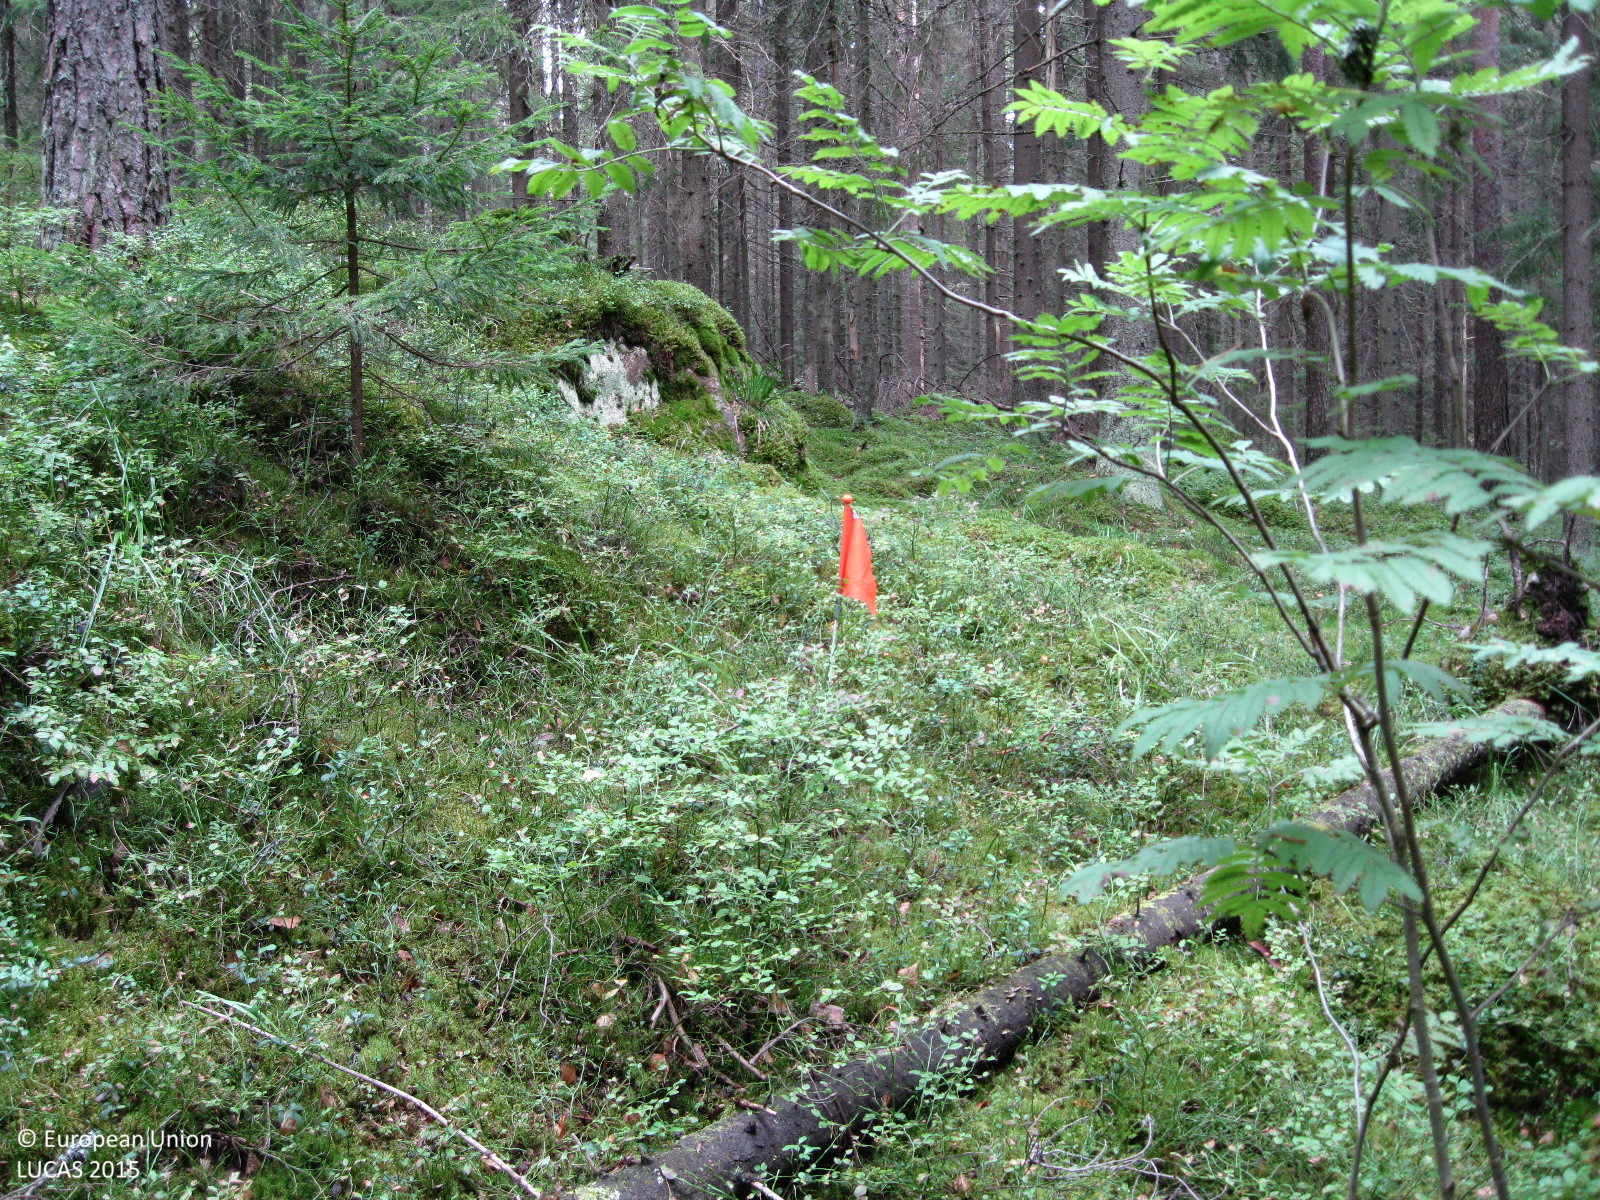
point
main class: Woodland
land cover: Spruce dominated coniferous woodland
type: boreal forest
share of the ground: > 75 %
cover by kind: coniferous forest trees 80 %, shrubs 10 %, broadleaved forest trees 5 %, lichens and mosses 5 %
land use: Forestry
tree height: > 5 m
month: September
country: FI
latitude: 60.6945
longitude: 25.0064
